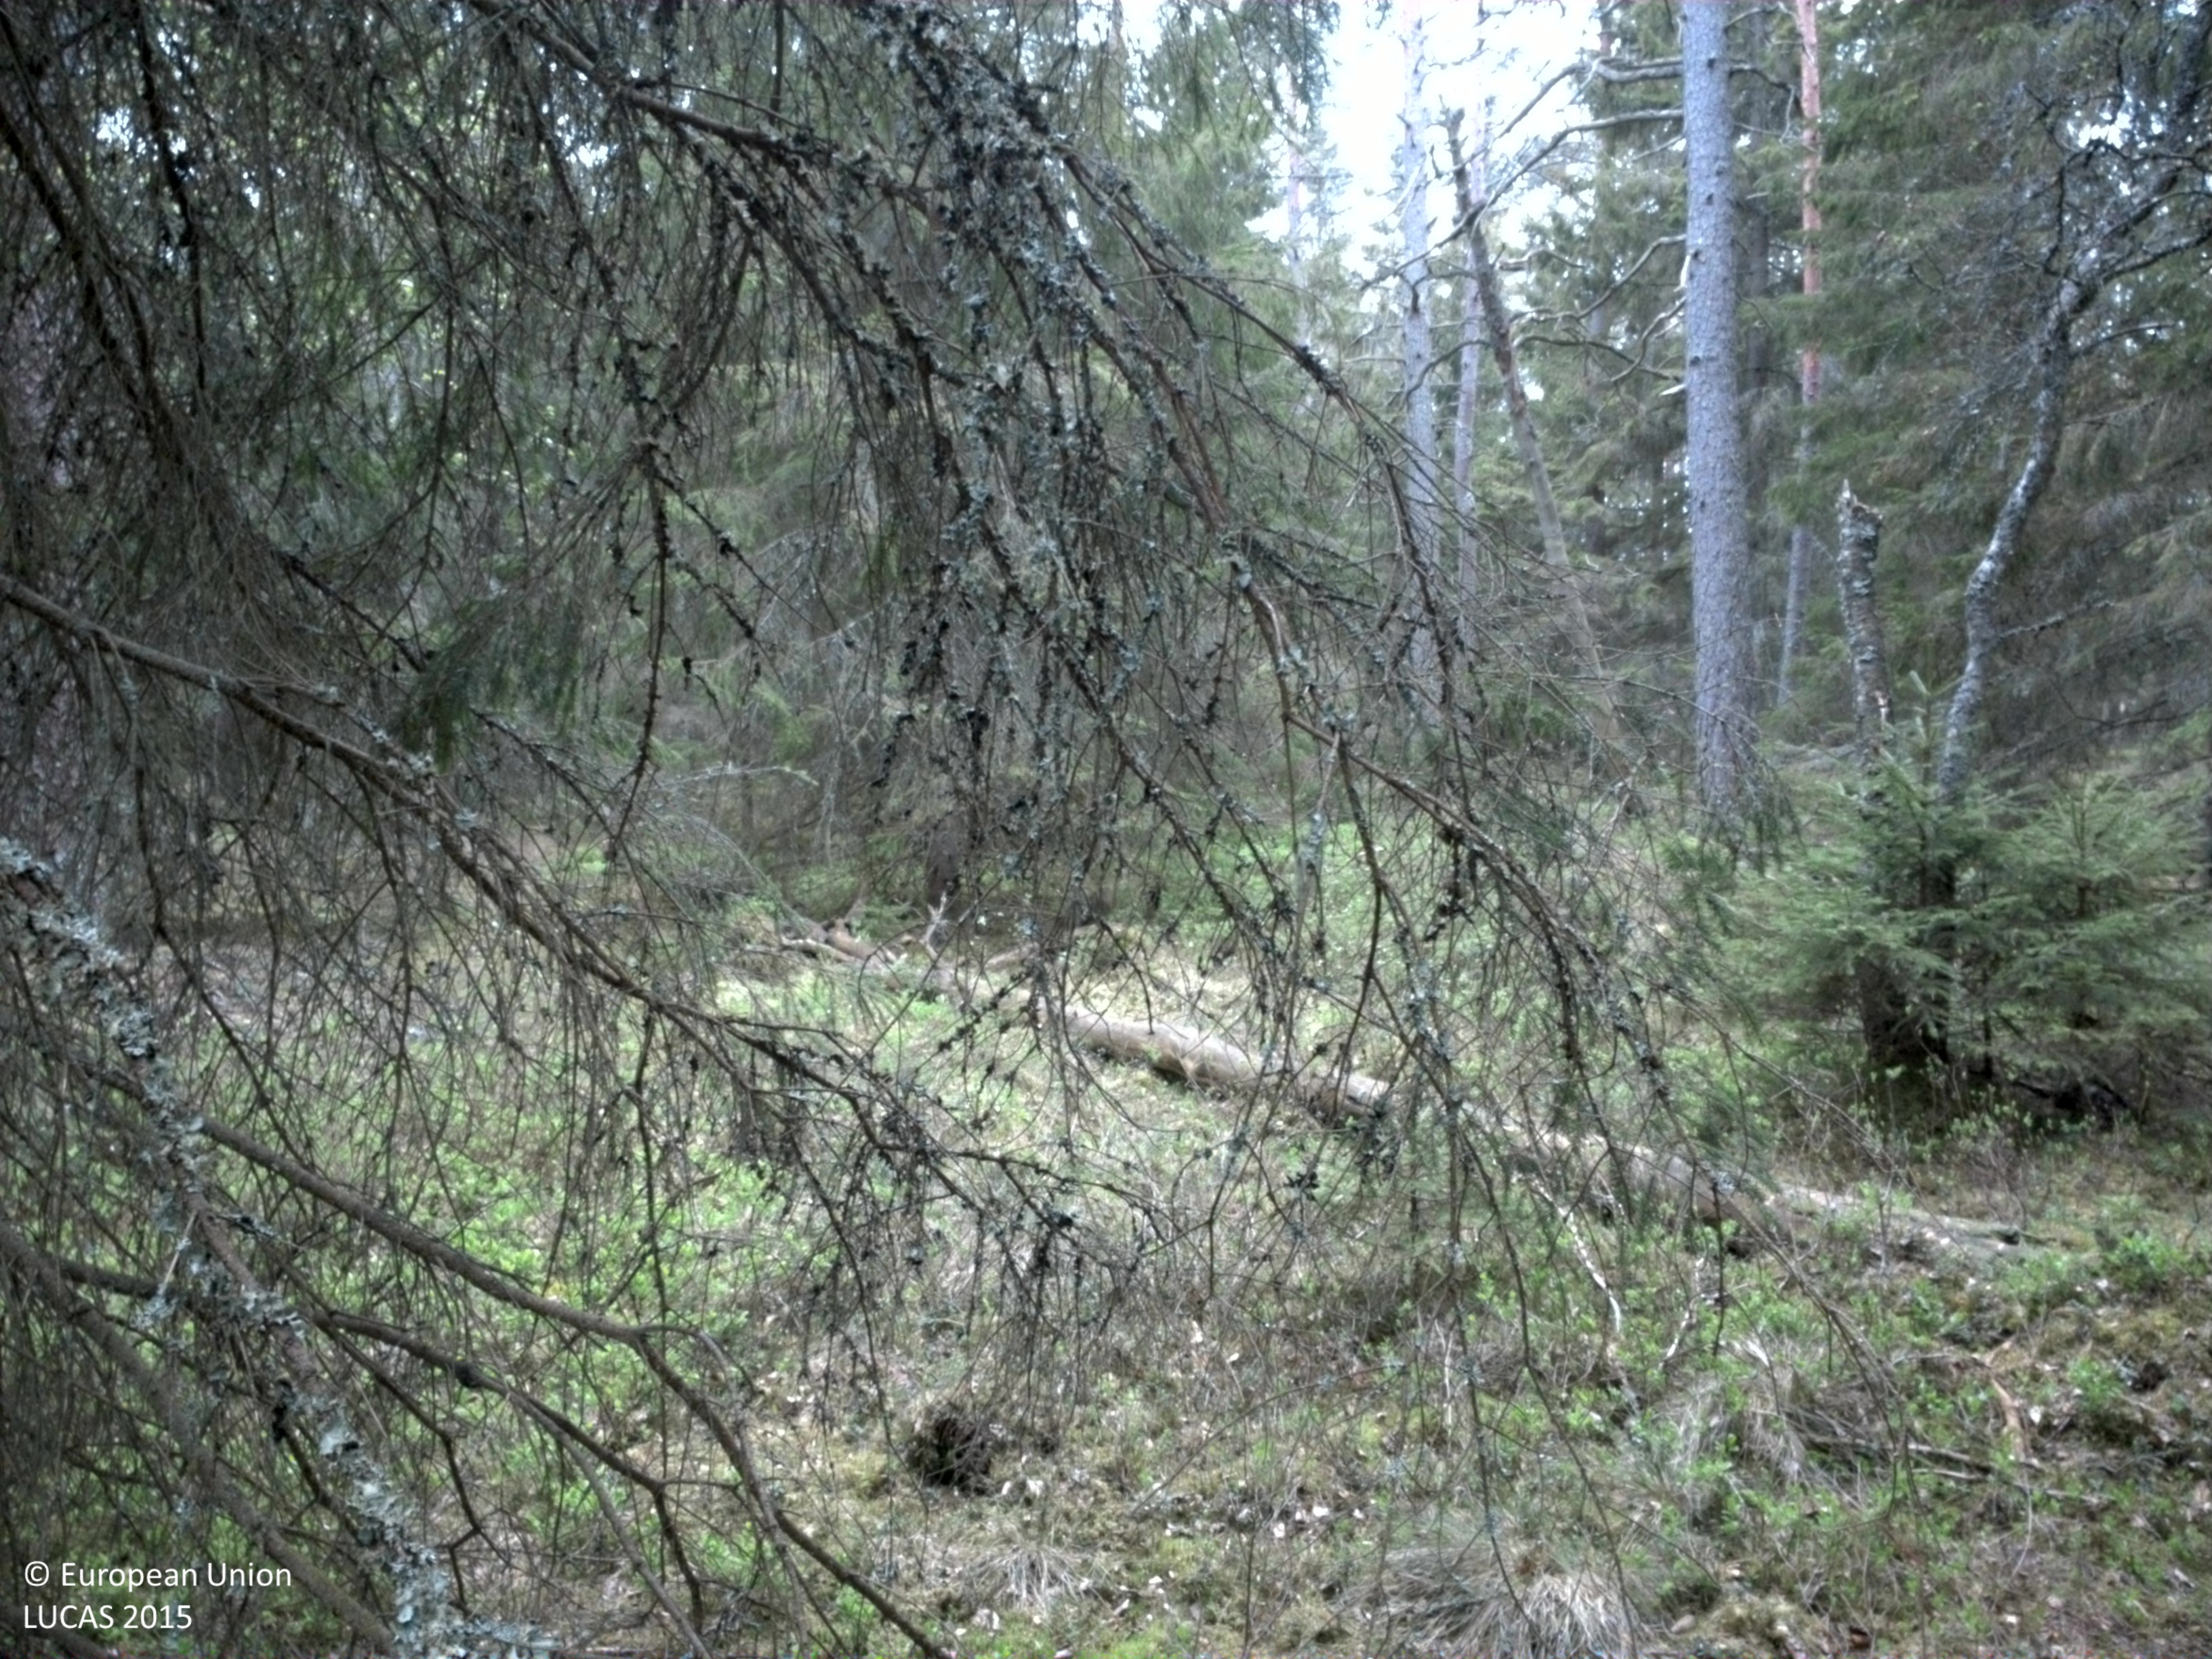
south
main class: Woodland
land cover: Spruce dominated coniferous woodland
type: boreal forest
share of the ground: 50 - 75 %
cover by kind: coniferous forest trees 60 %, shrubs 15 %, lichens and mosses 15 %, broadleaved forest trees 10 %
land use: Forestry
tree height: > 5 m
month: May
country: SE
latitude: 57.0047
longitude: 15.1178
